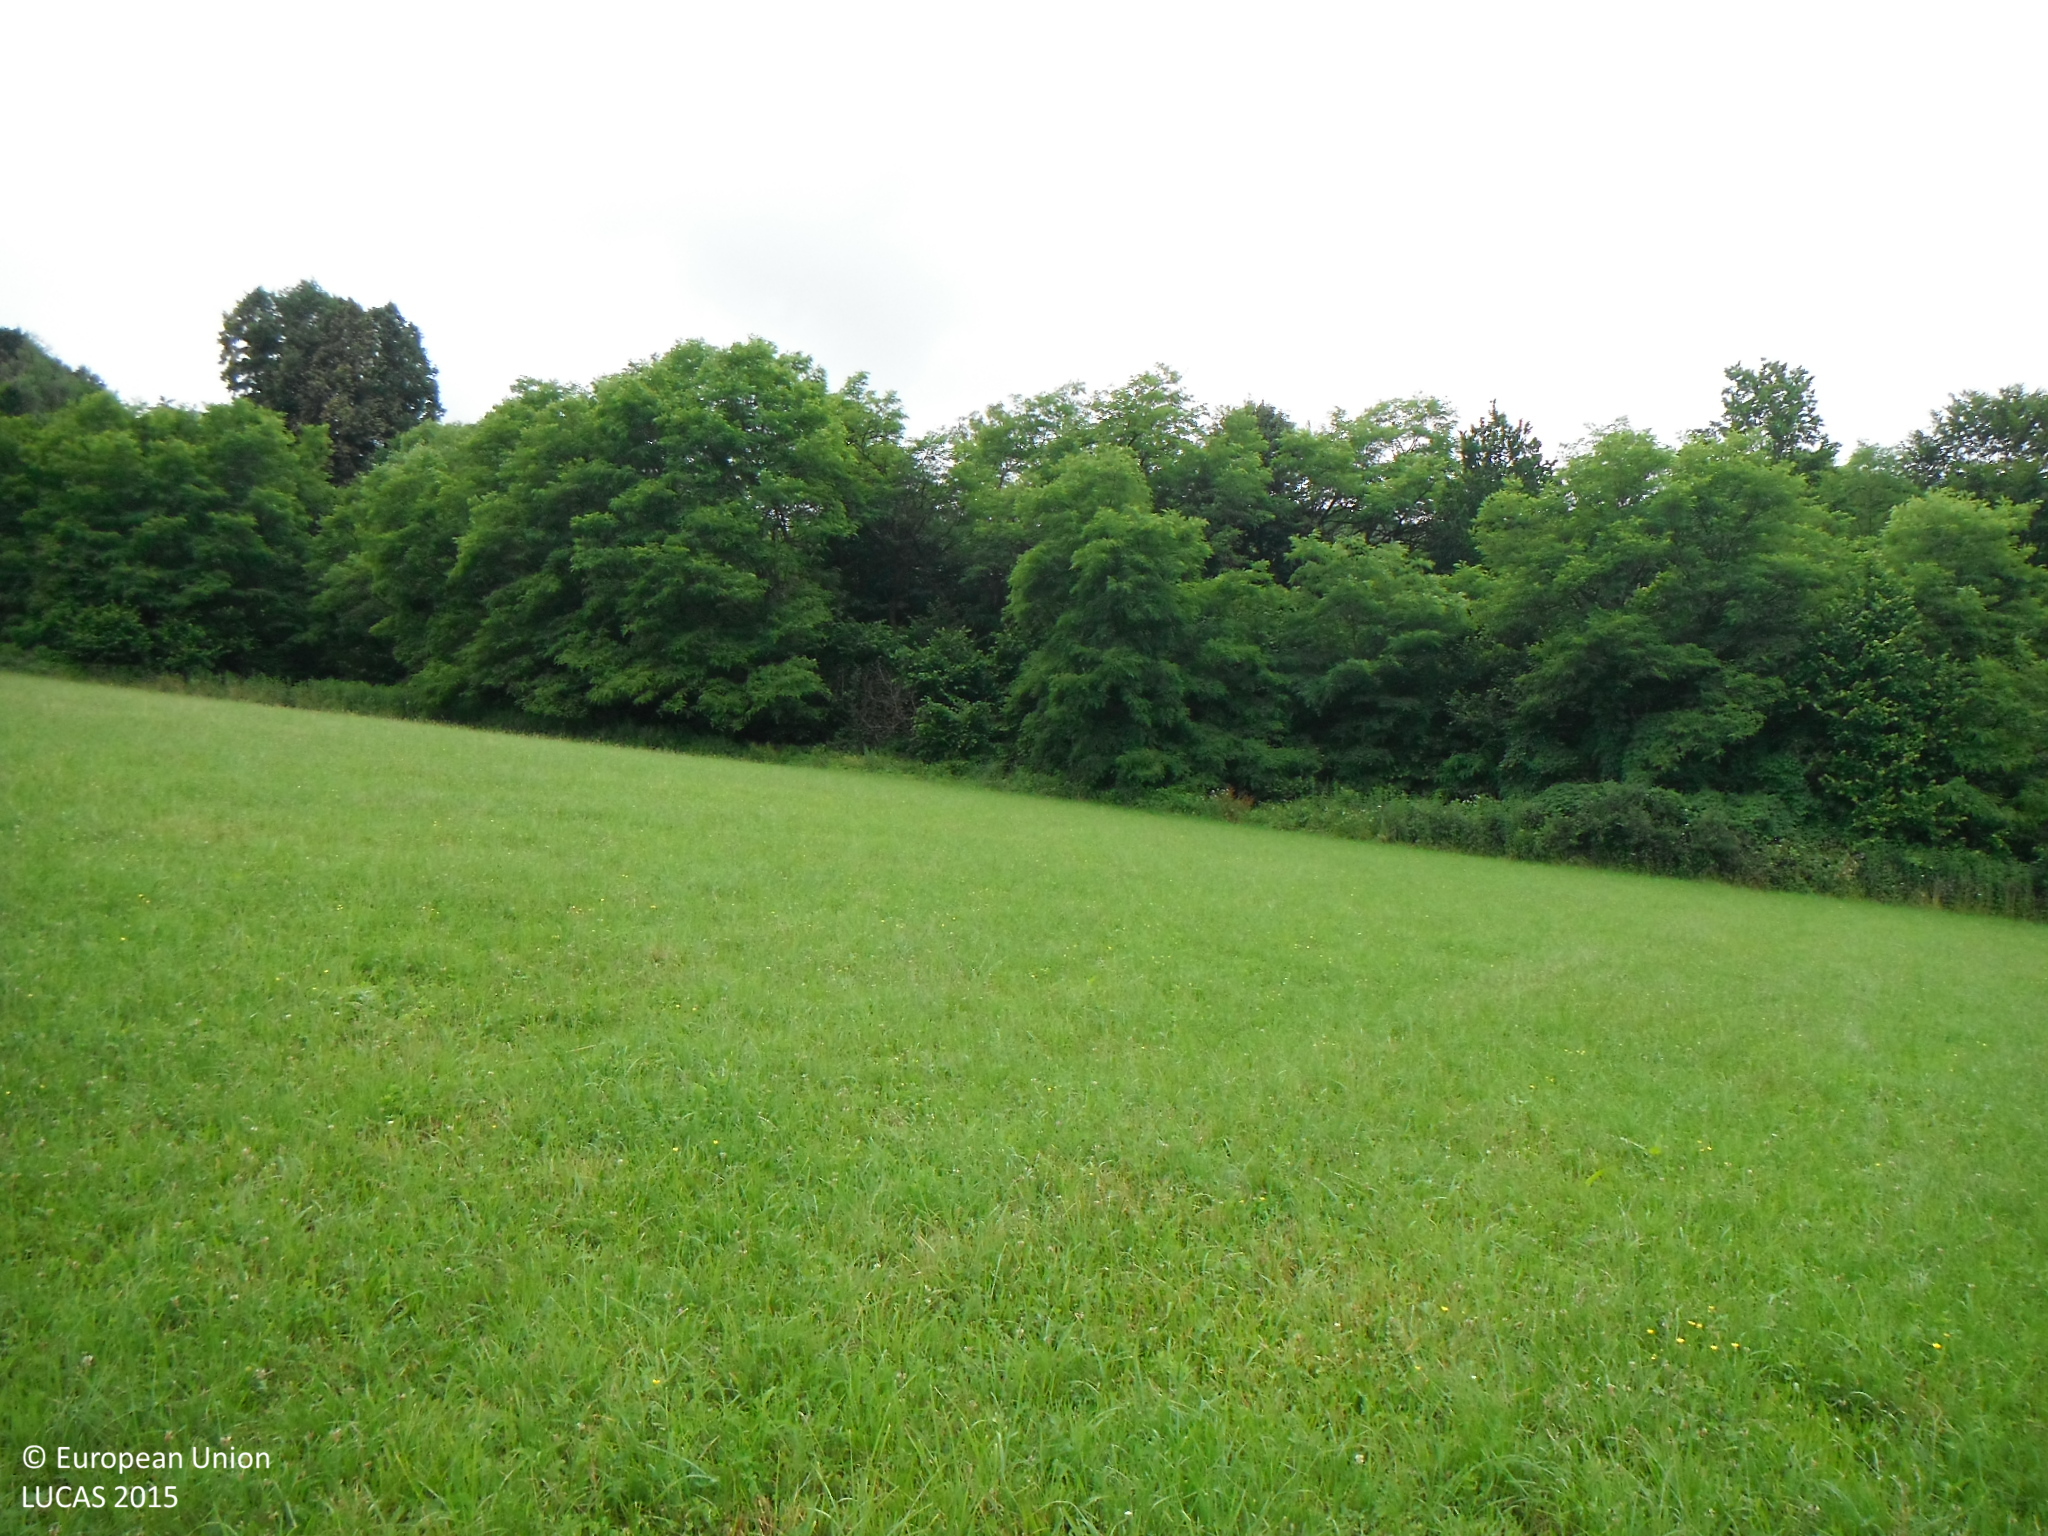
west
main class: Grassland
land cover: Grassland without tree/shrub cover
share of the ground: > 75 %
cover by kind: herbaceous plants 100 %
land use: Agriculture (excluding fallow land and kitchen gardens)
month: June
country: SK
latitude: 48.5890
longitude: 19.9397
